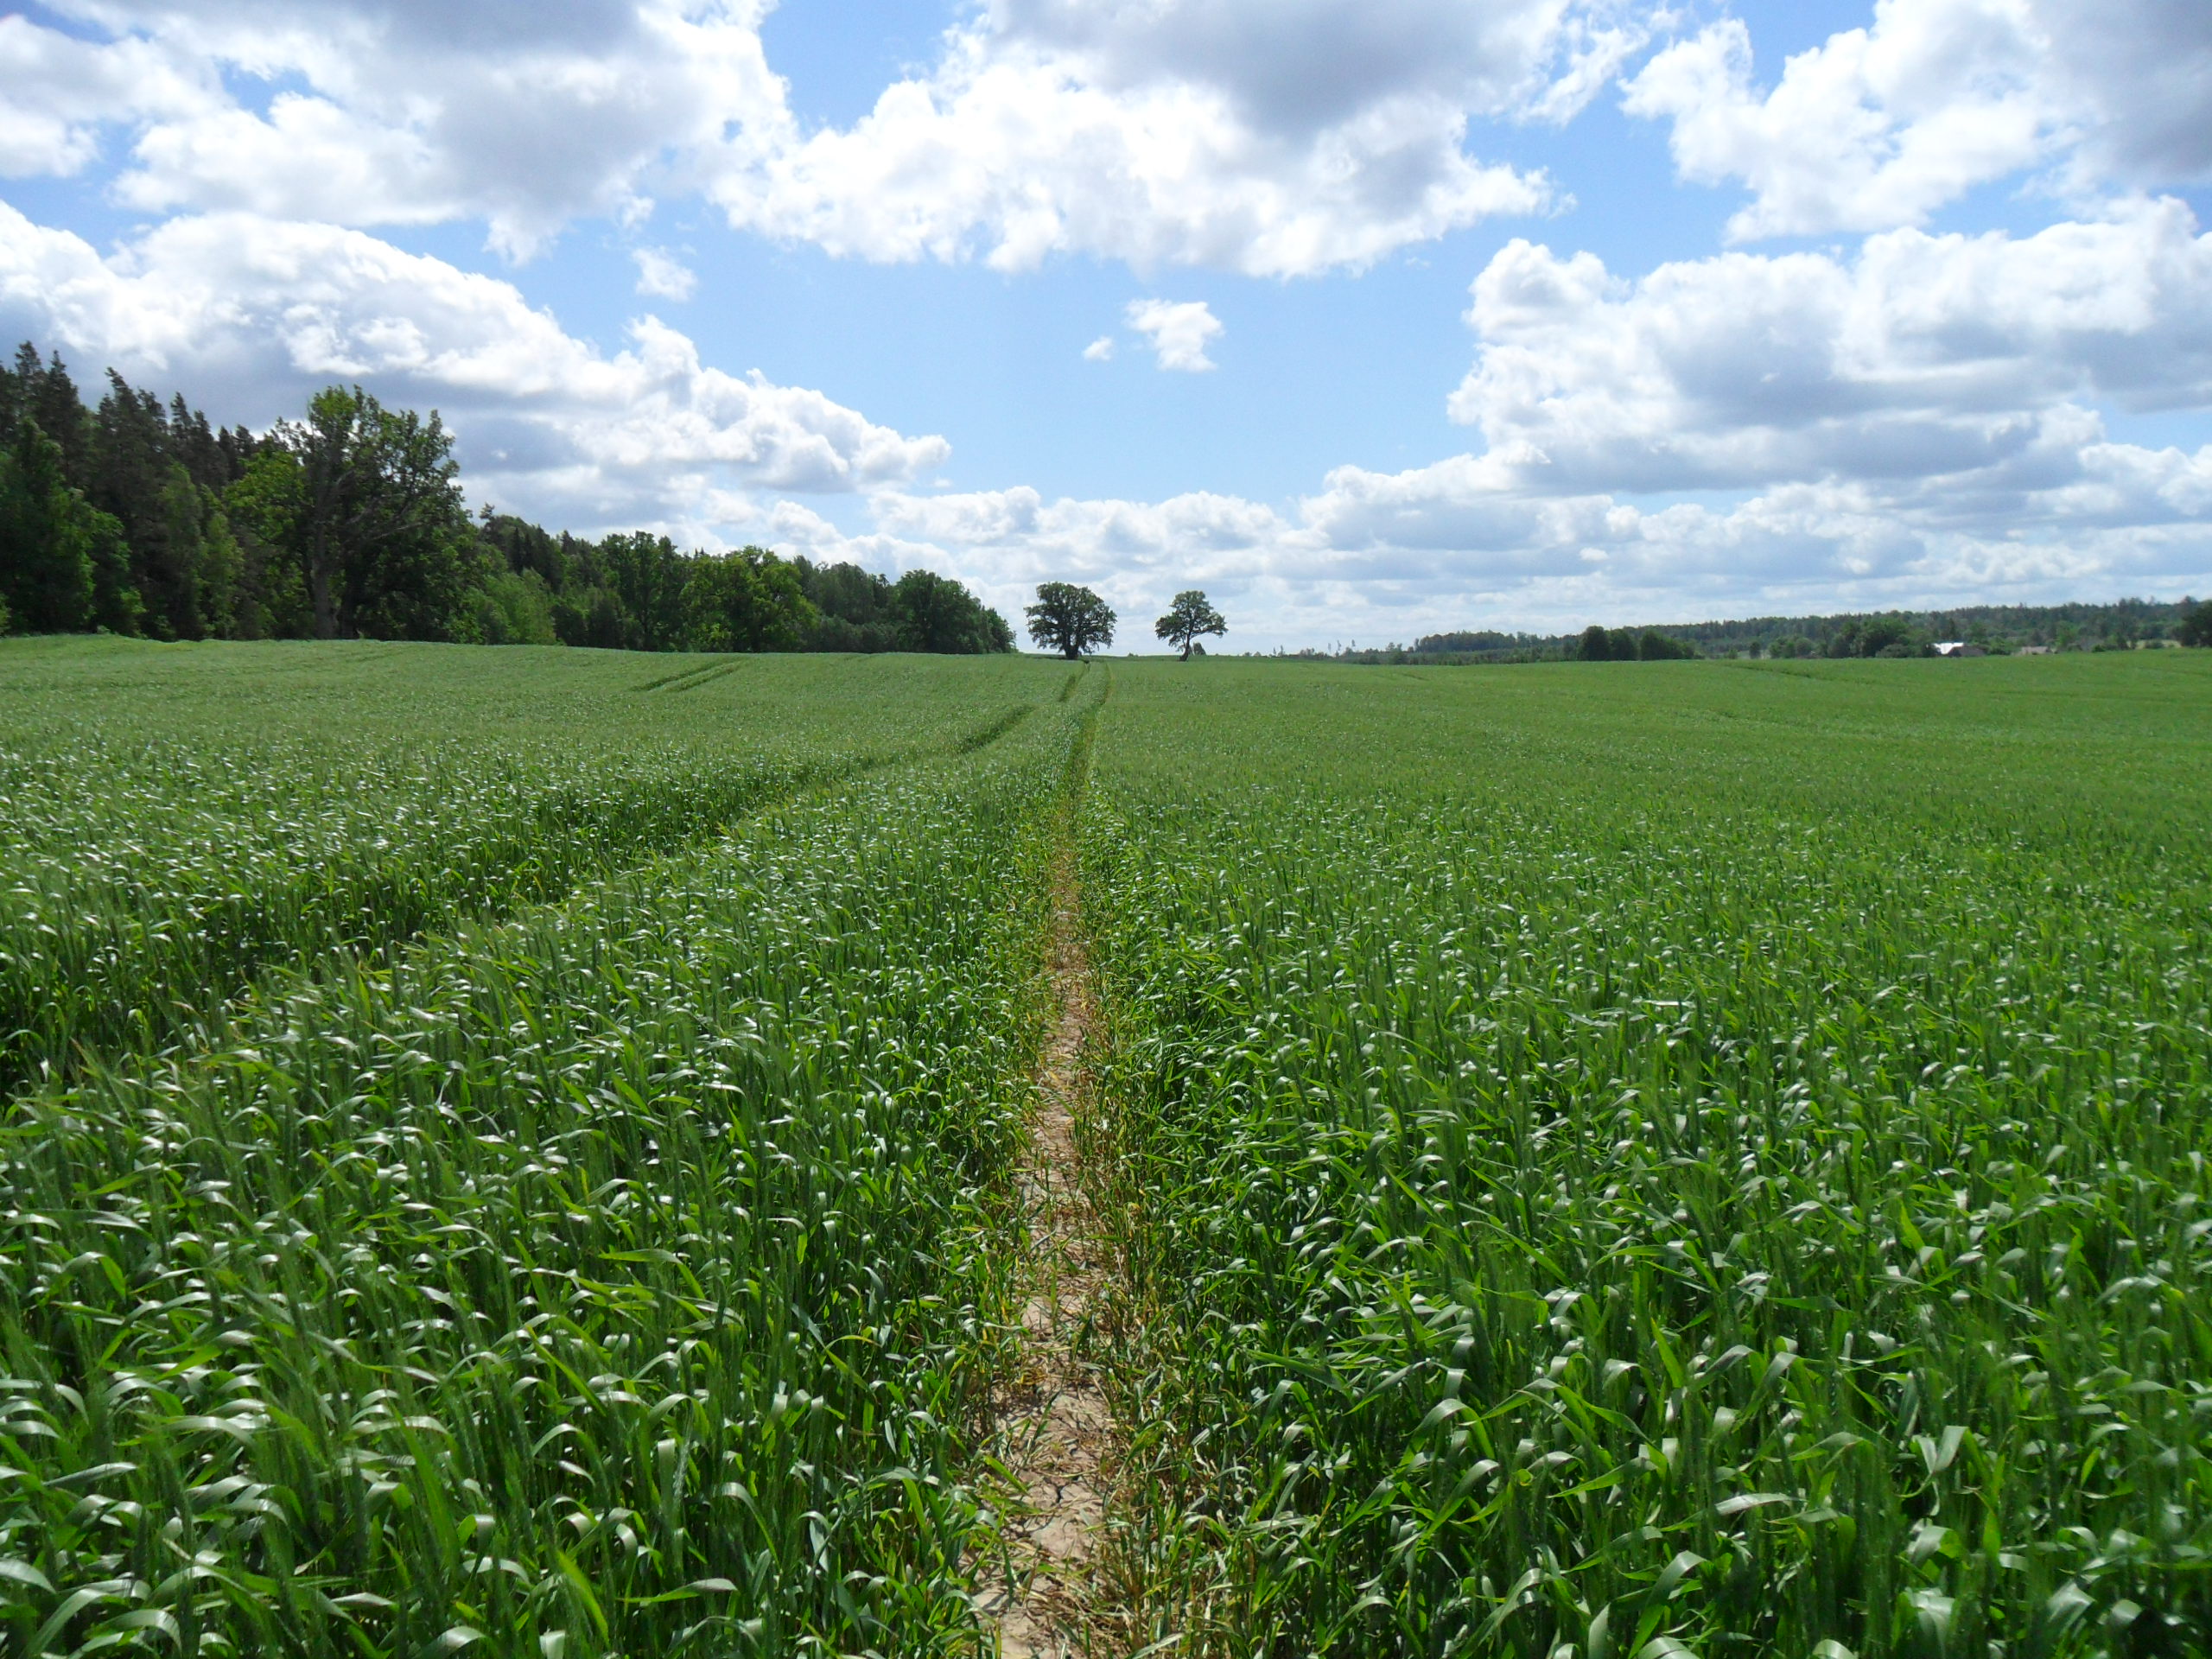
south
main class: Cropland
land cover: Triticale
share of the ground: > 75 %
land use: Agriculture (excluding fallow land and kitchen gardens)
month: June
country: LV
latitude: 57.0579
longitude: 22.9732
